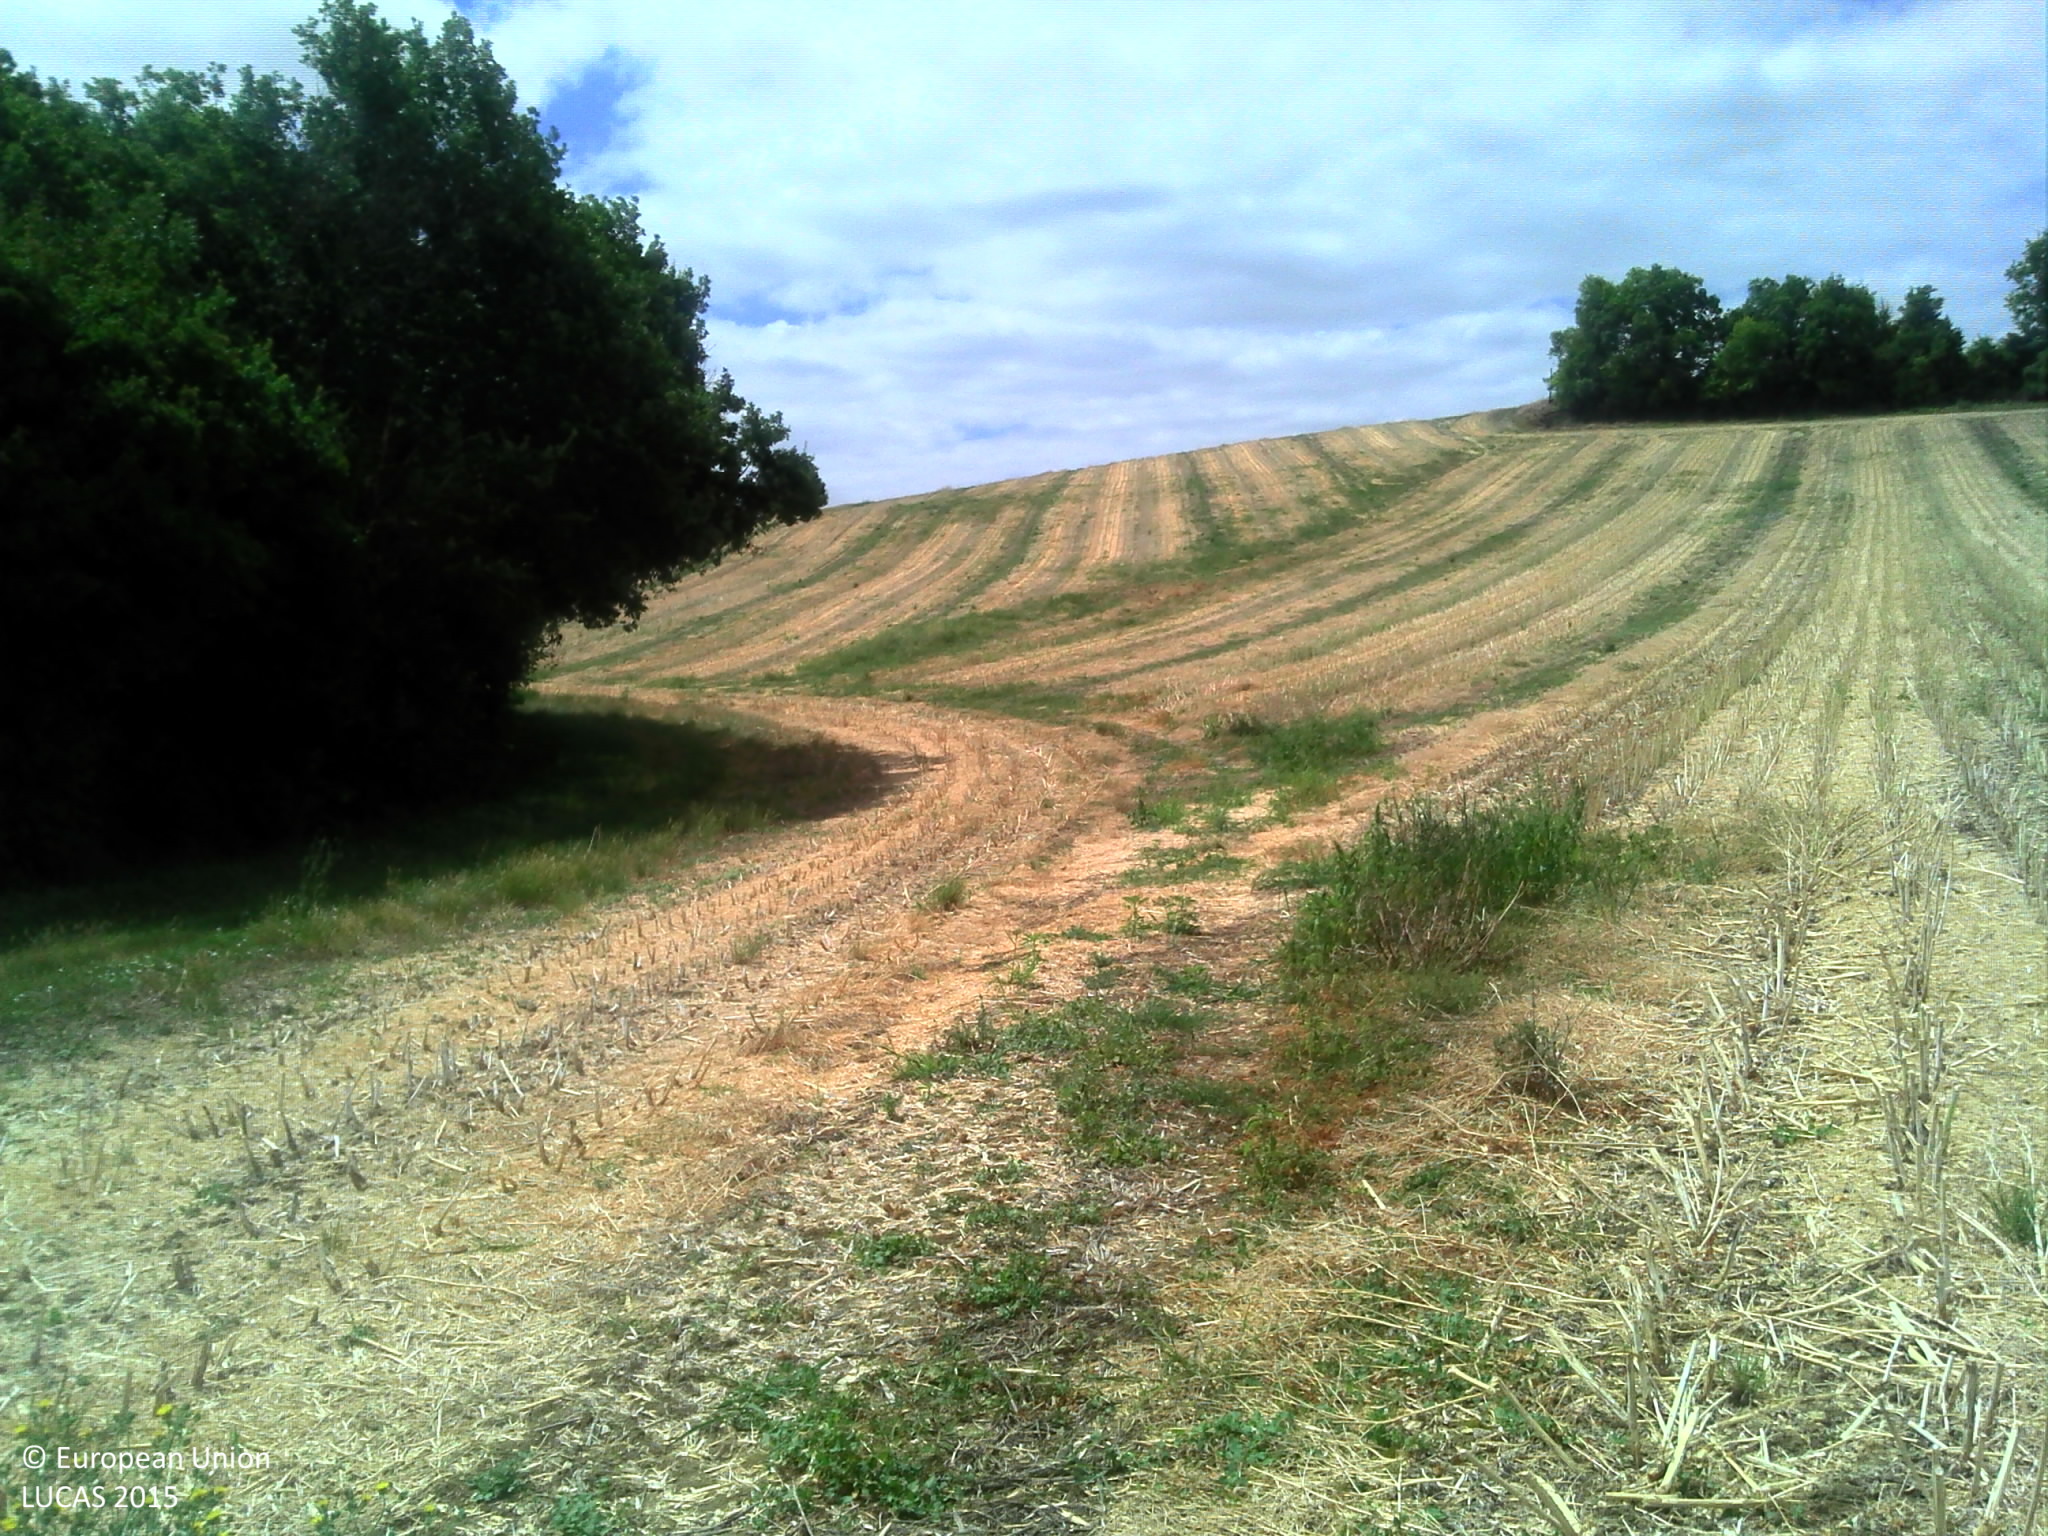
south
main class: Cropland
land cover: Rape and turnip rape
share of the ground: > 75 %
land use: Agriculture (excluding fallow land and kitchen gardens)
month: July
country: FR
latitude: 43.9157
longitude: 0.7192
